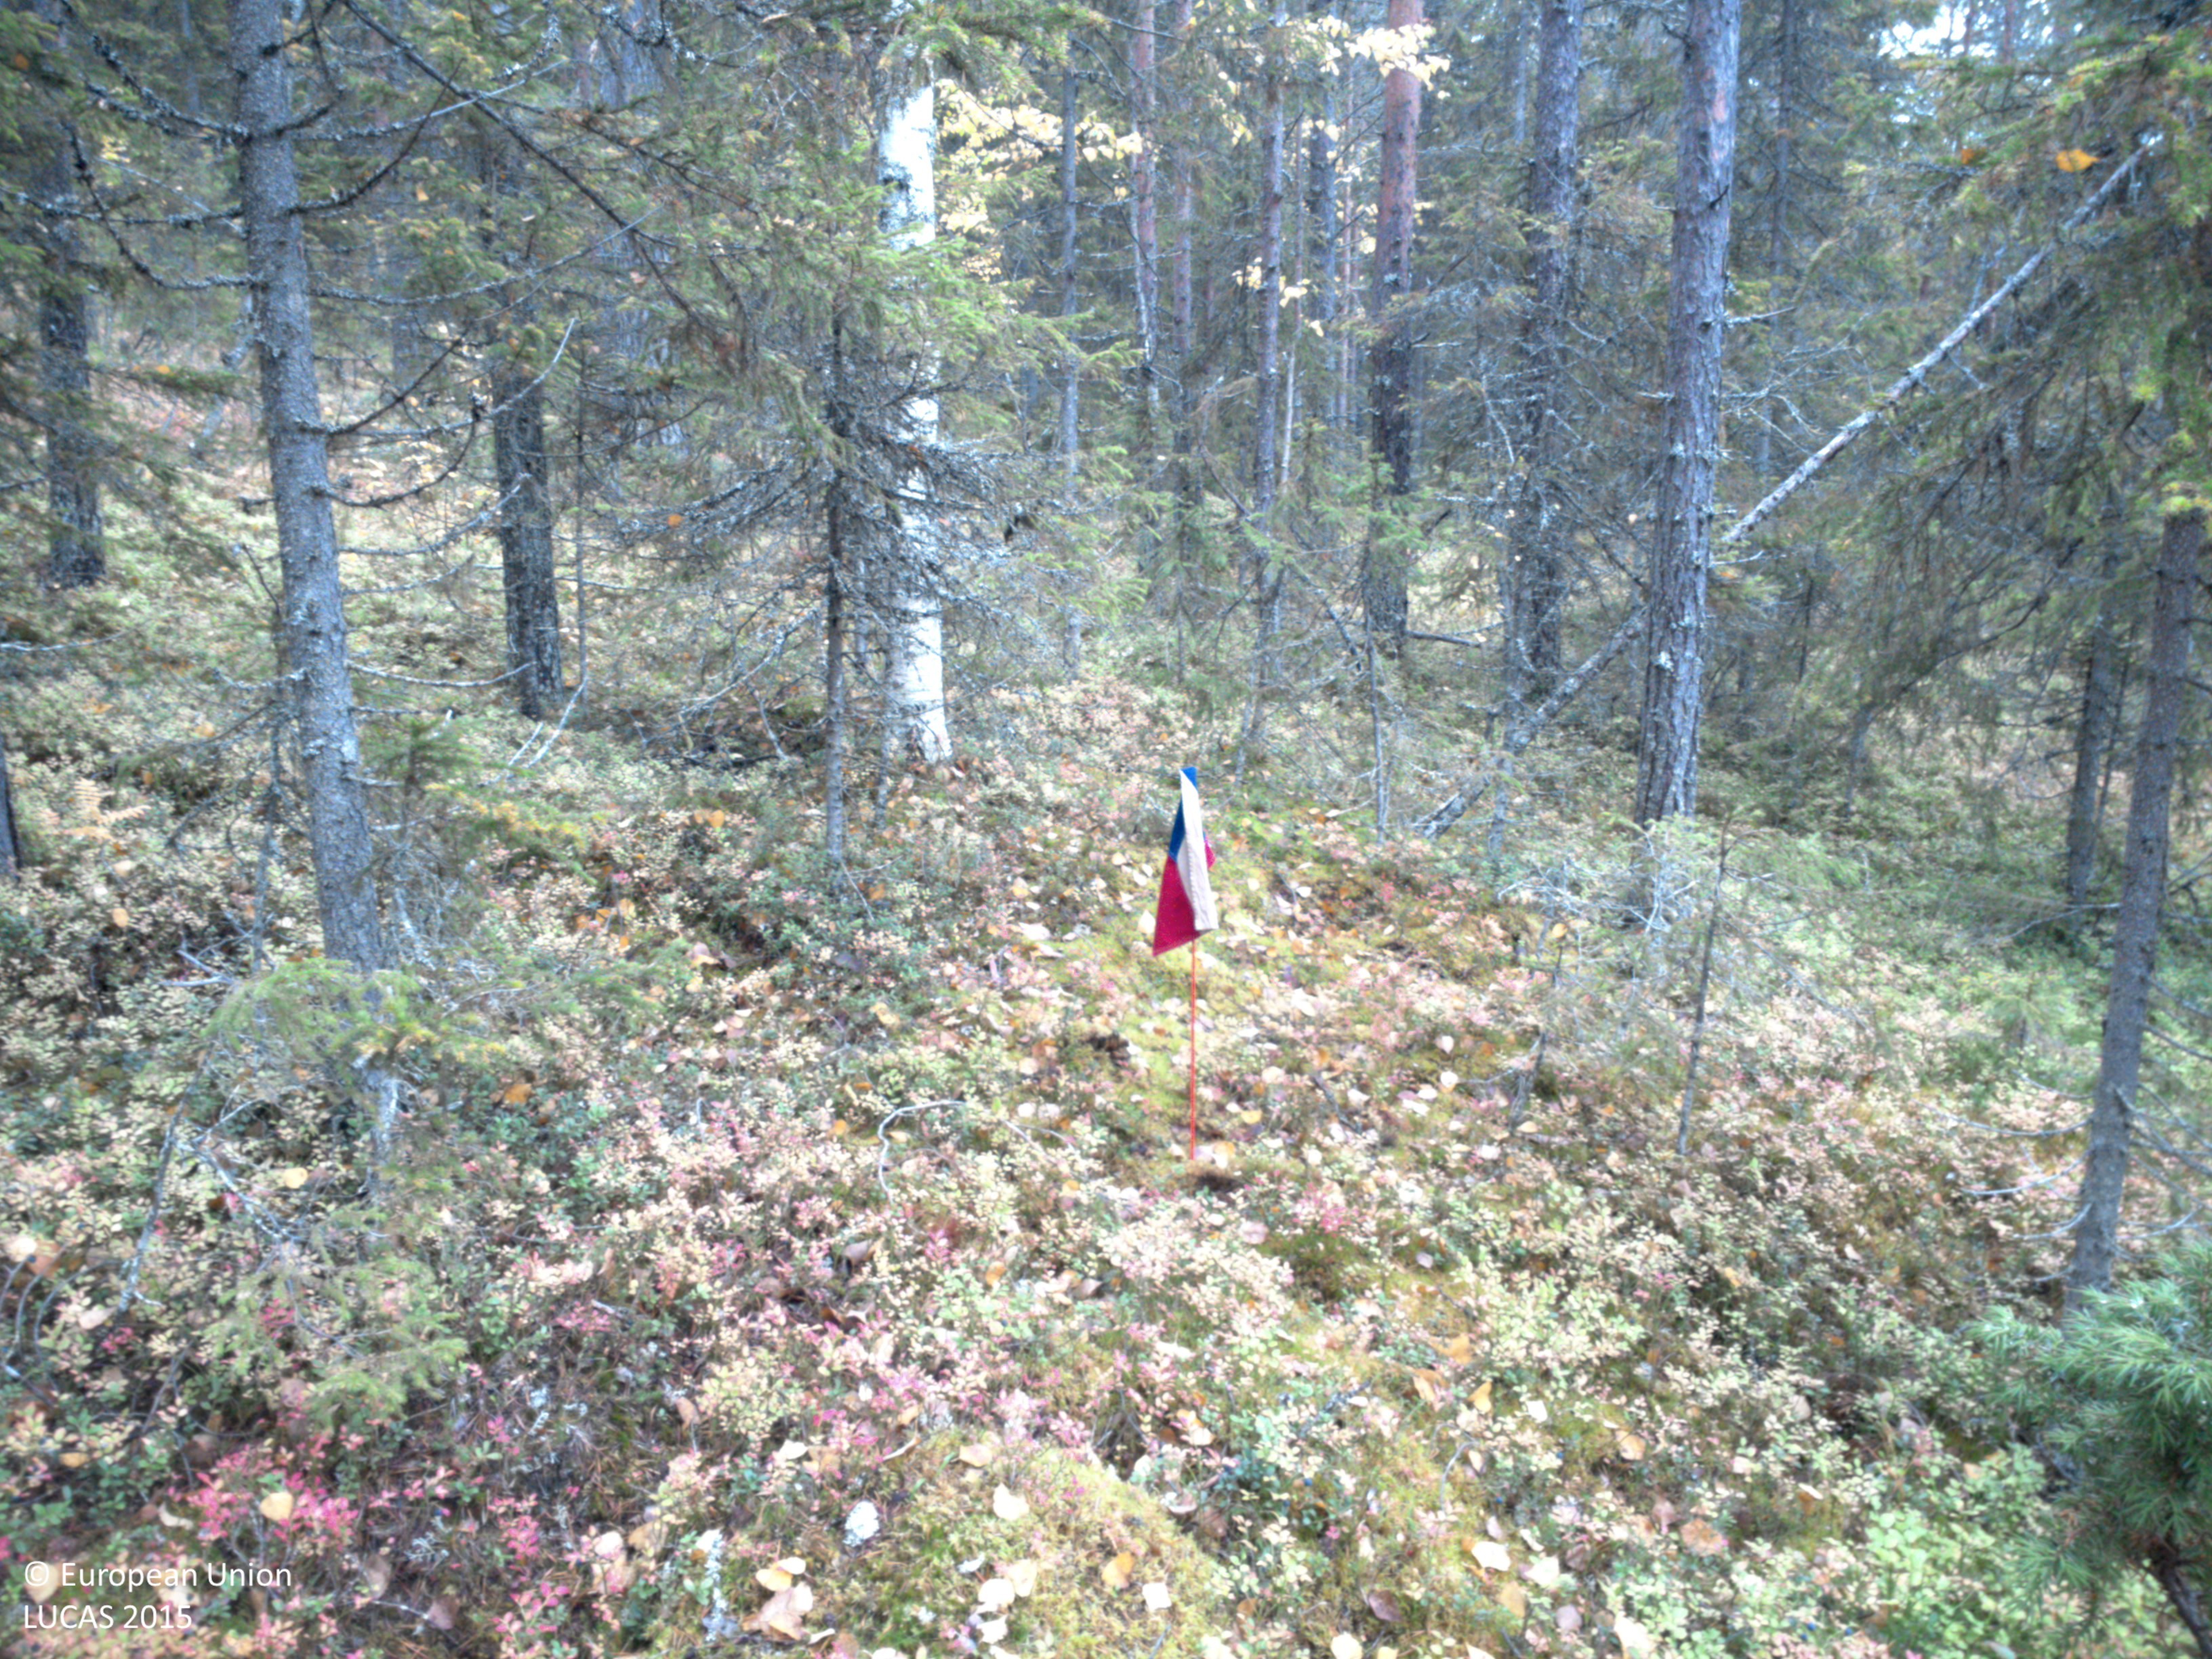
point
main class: Woodland
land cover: Other coniferous woodland
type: boreal forest
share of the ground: > 75 %
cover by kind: coniferous forest trees 75 %, broadleaved forest trees 10 %, shrubs 5 %, herbaceous plants 5 %, lichens and mosses 5 %
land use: Forestry
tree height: > 5 m
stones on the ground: < 10 %
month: September
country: SE
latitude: 64.8761
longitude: 18.8953
